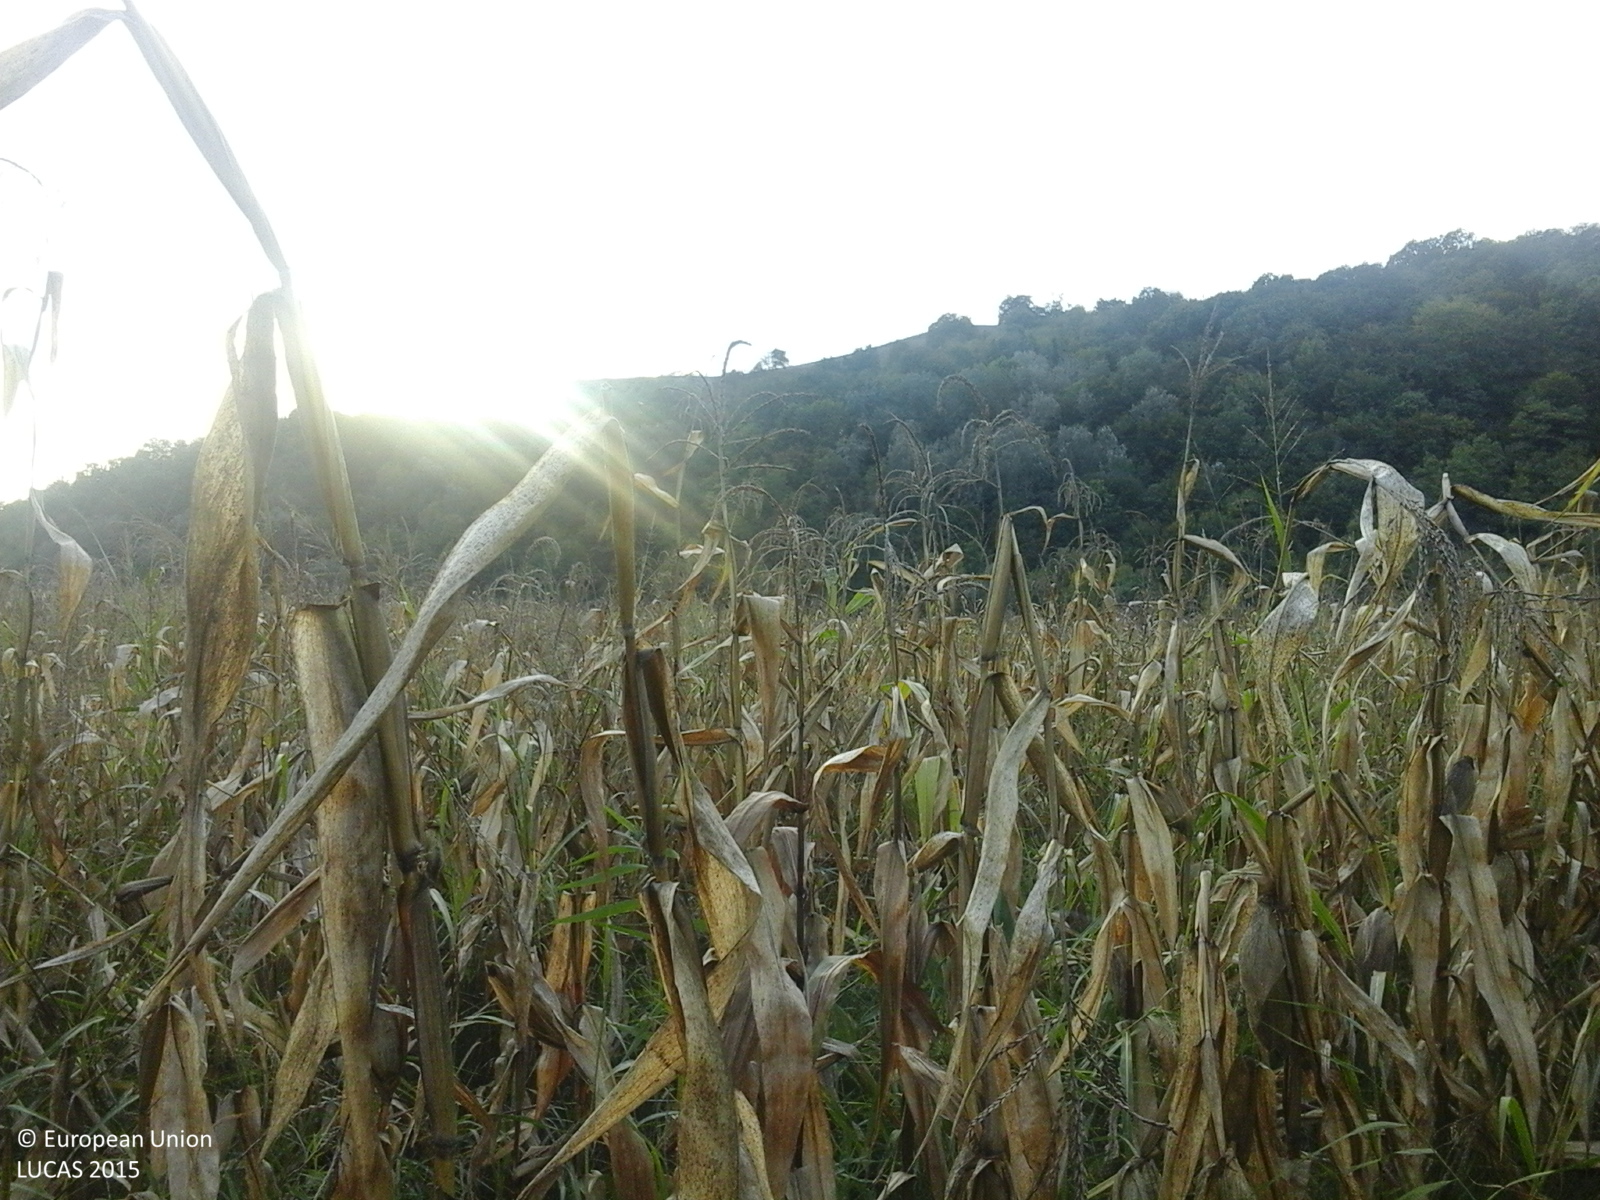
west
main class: Cropland
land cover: Maize
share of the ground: > 75 %
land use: Agriculture (excluding fallow land and kitchen gardens)
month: October
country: RO
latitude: 46.2145
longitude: 24.5124
